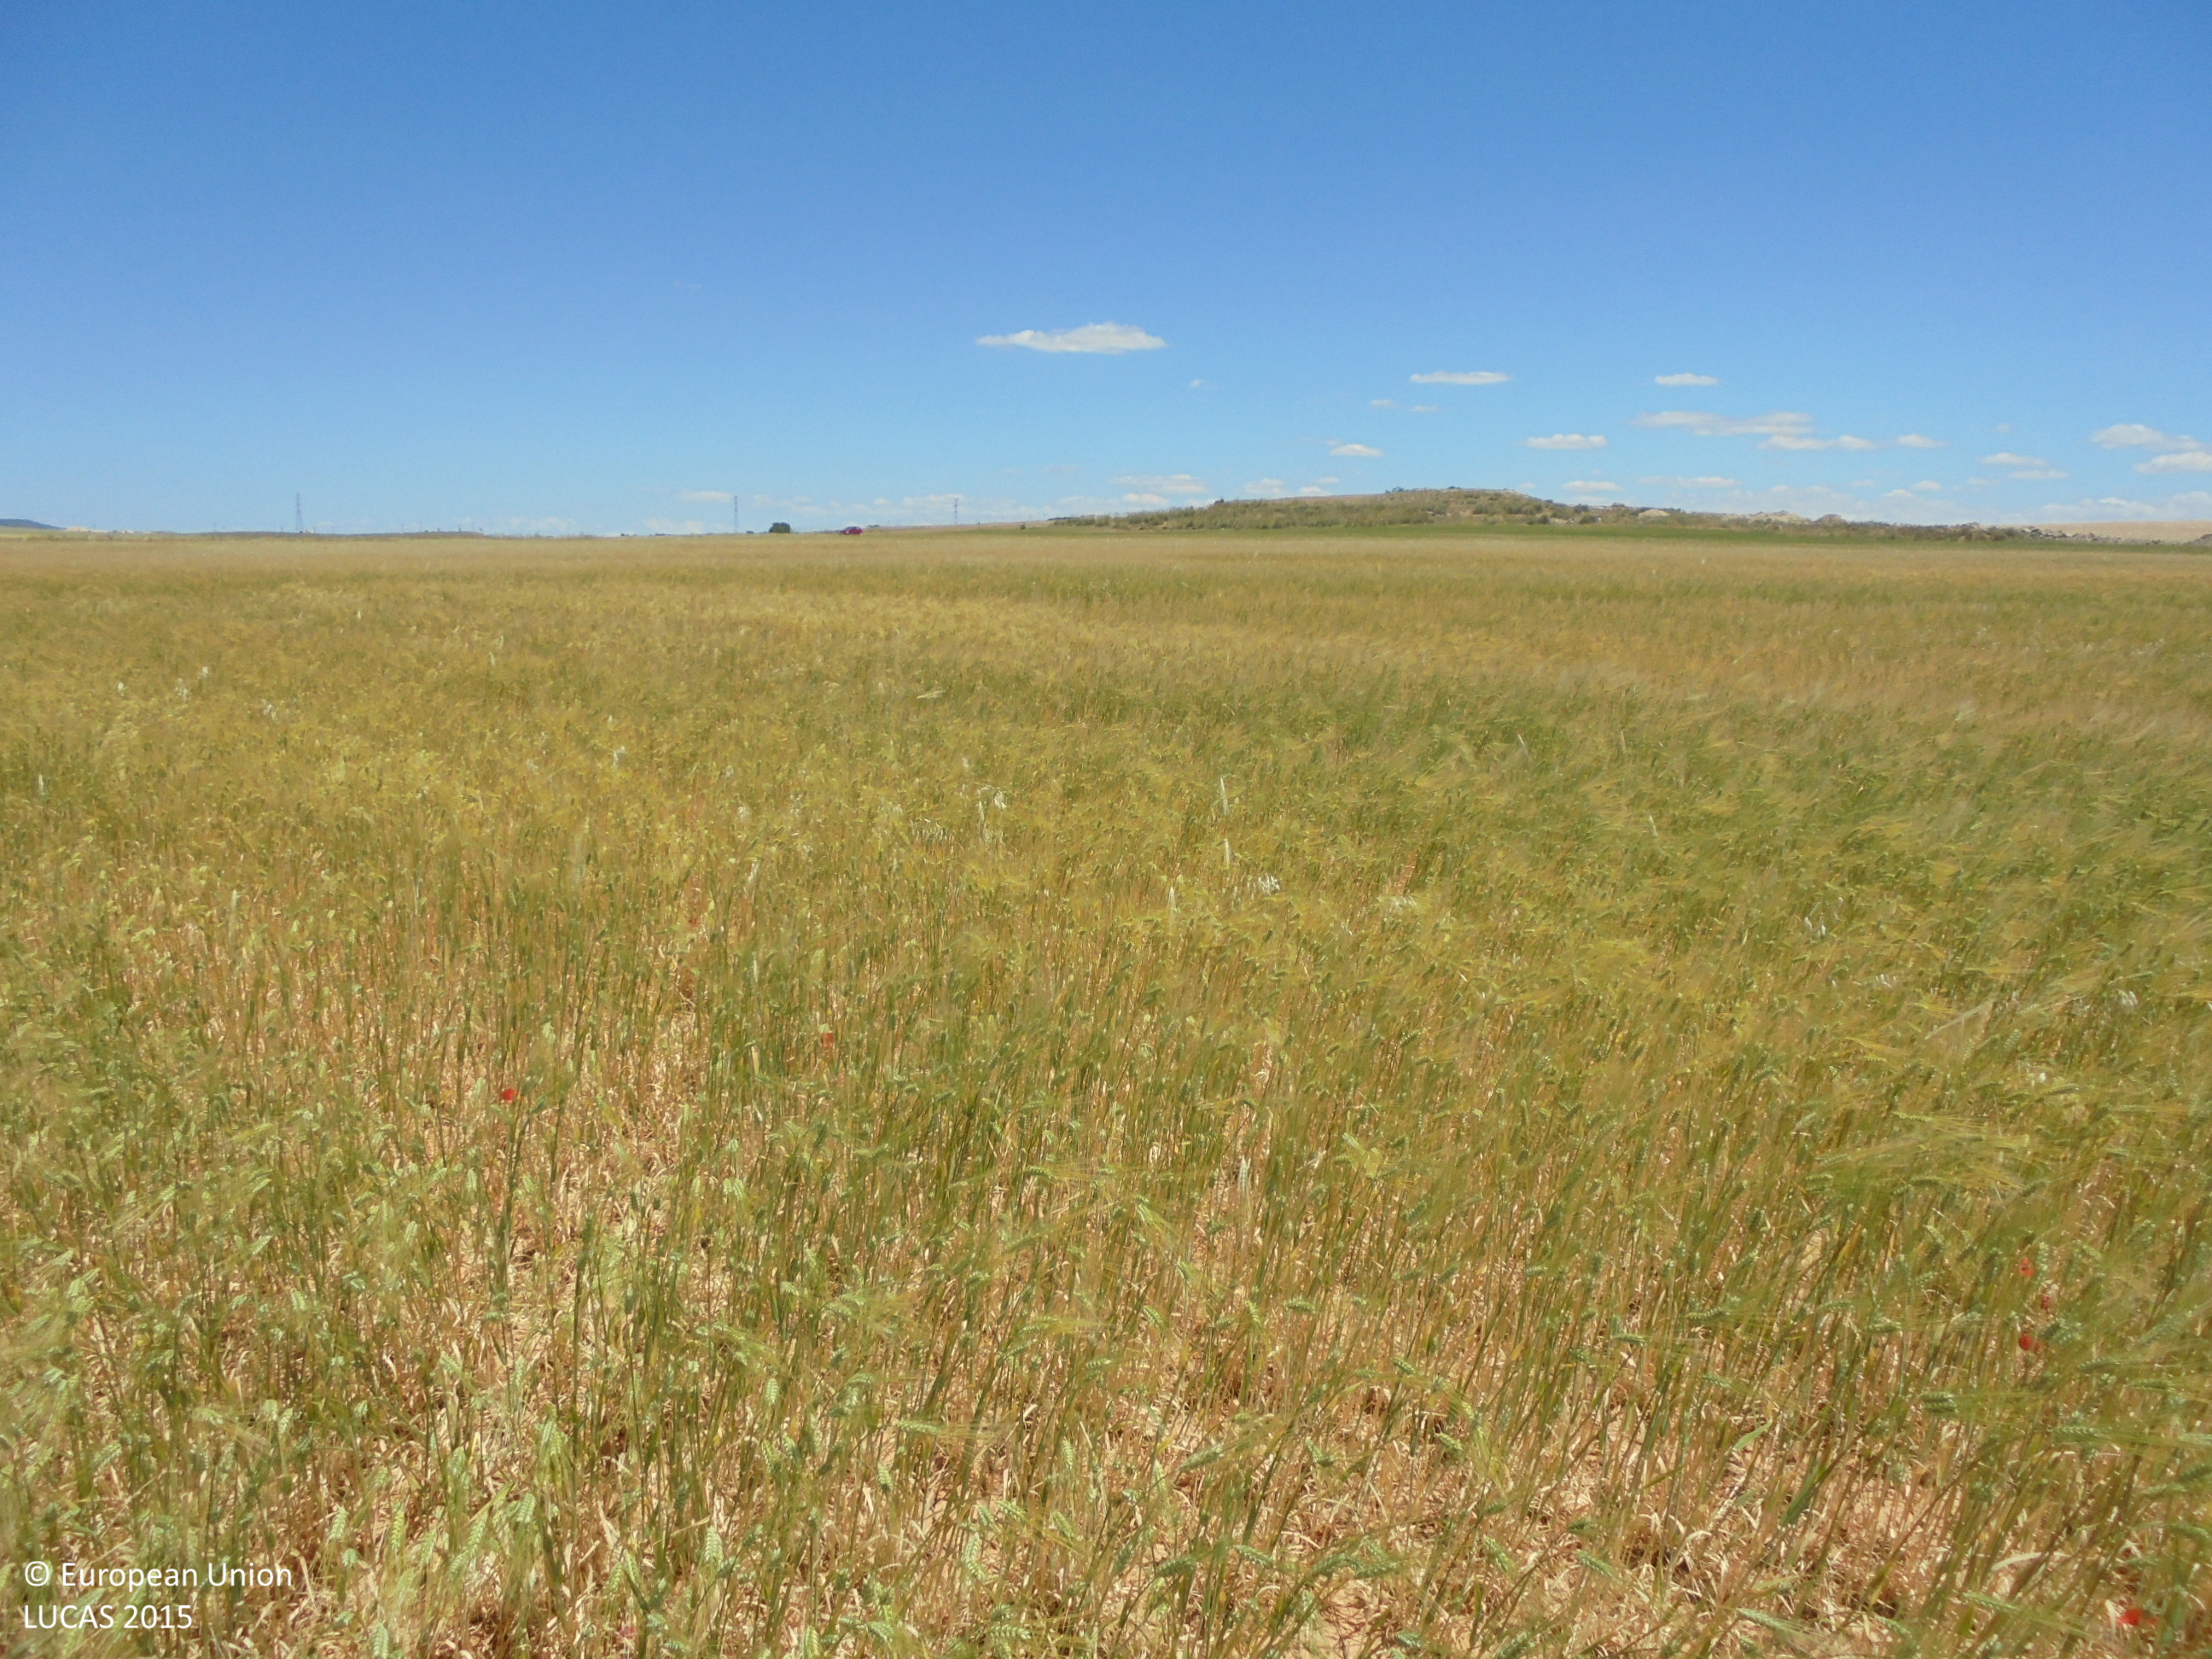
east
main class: Cropland
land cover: Barley
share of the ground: > 75 %
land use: Agriculture (excluding fallow land and kitchen gardens)
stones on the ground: < 10 %
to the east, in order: Barley; Shrubland without tree cover
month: May
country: ES
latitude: 38.8832
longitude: -1.7451
